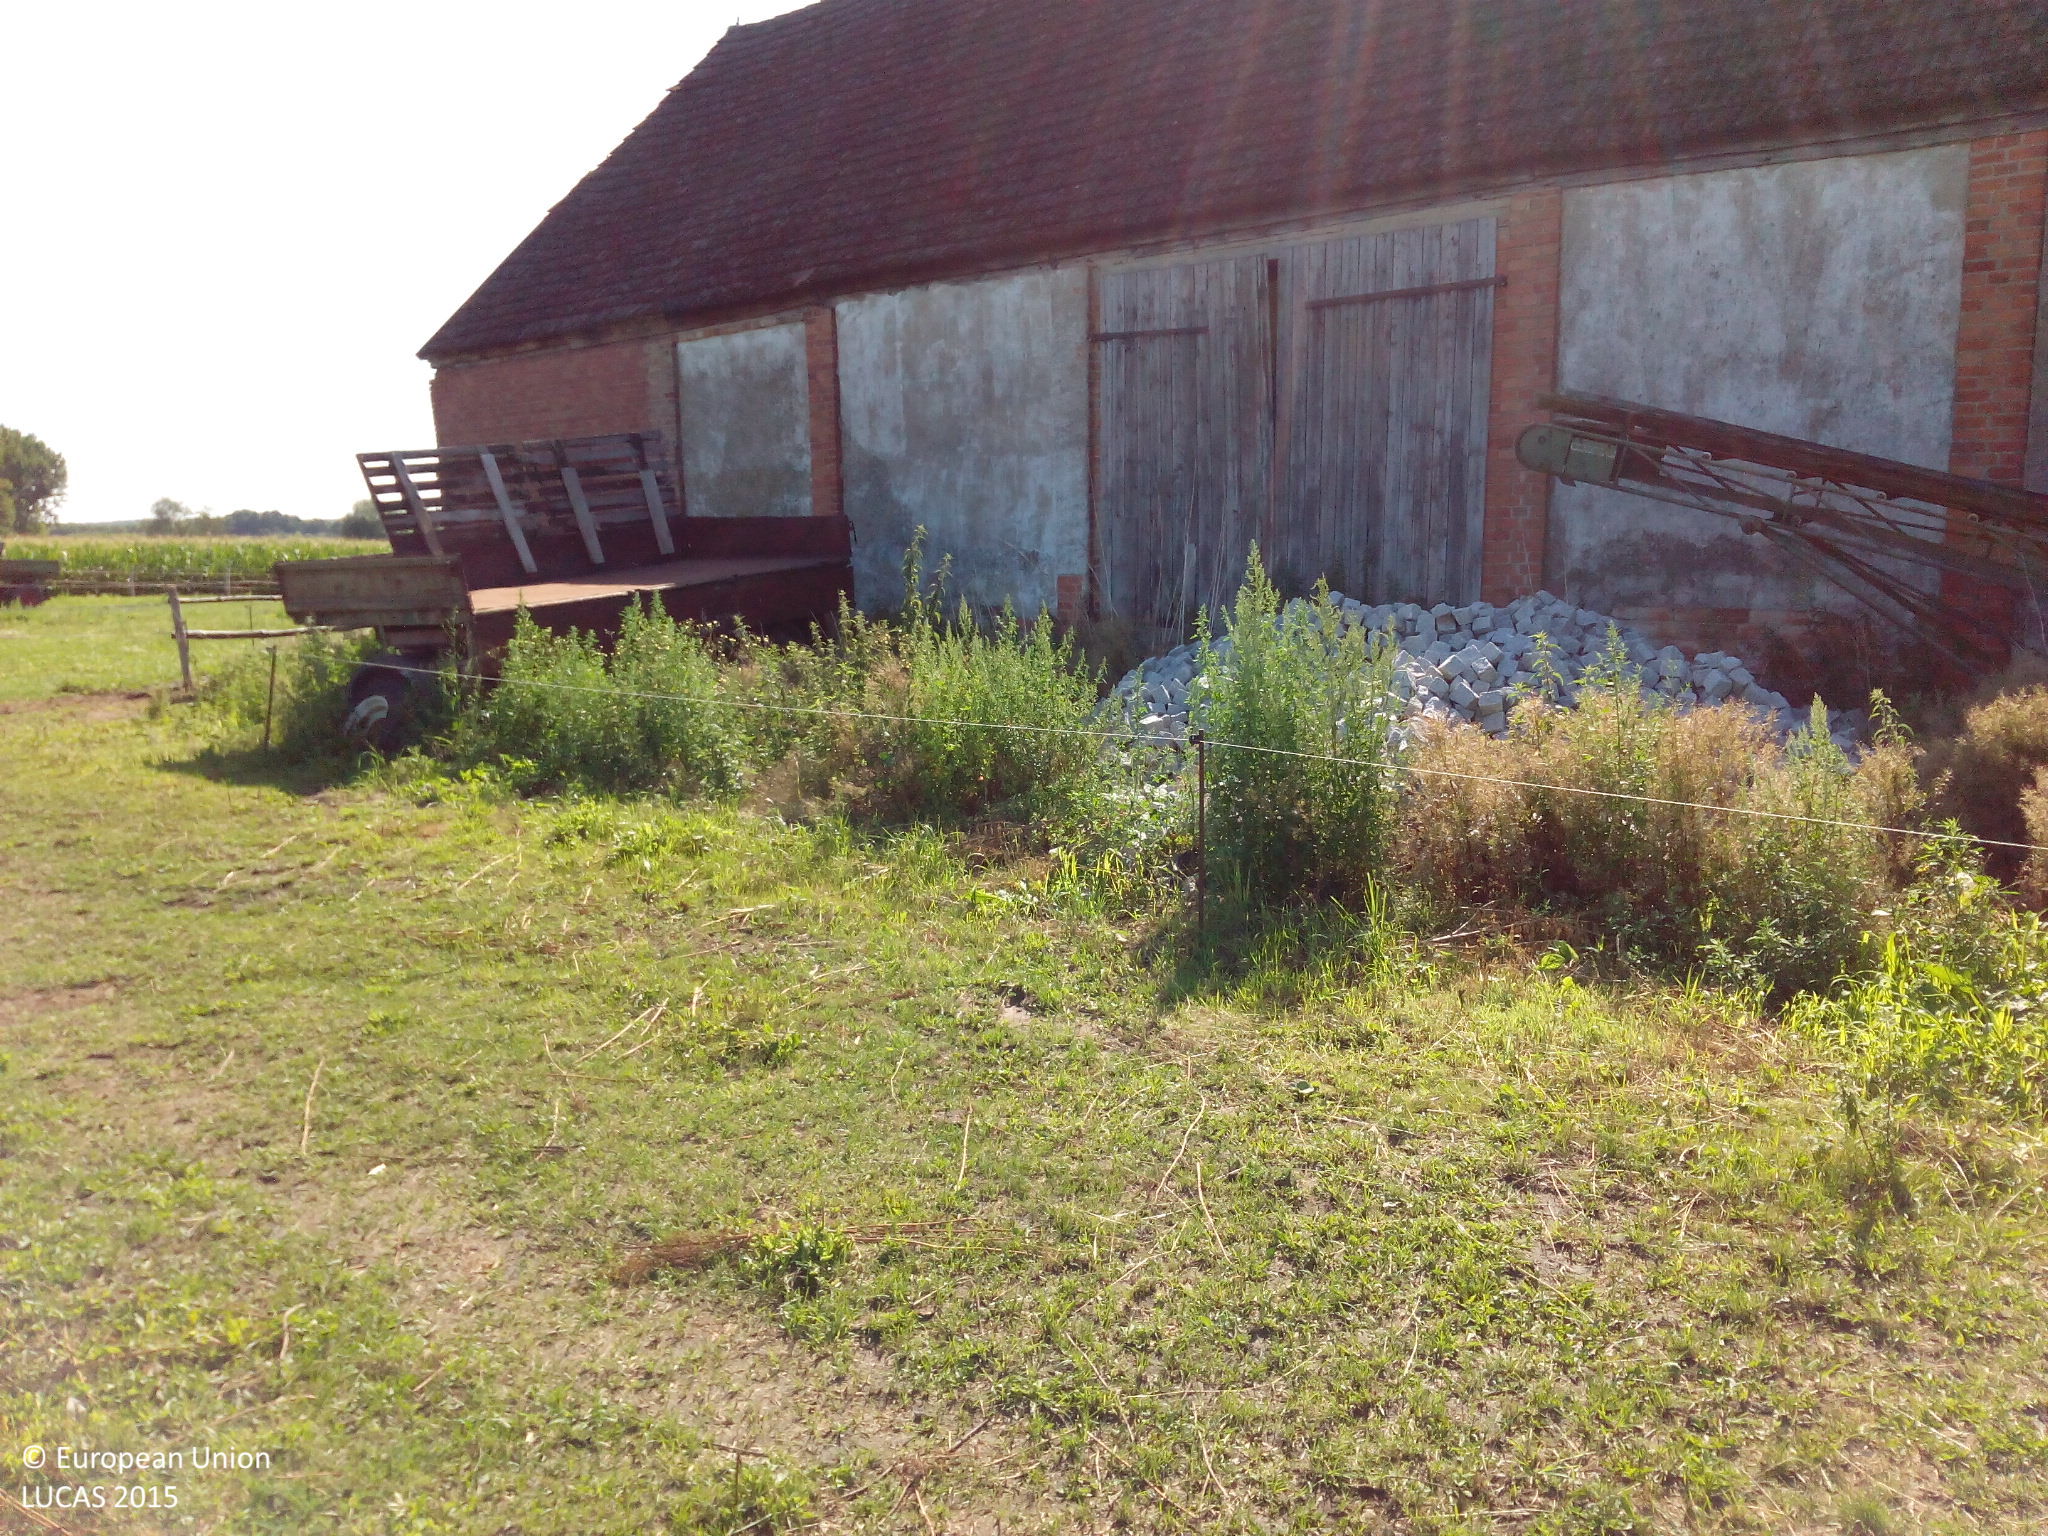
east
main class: Cropland
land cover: Maize
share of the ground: > 75 %
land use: Agriculture (excluding fallow land and kitchen gardens)
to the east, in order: Maize; Fences; Grassland without tree/shrub cover; Fences; Maize; Fences; Grassland without tree/shrub cover; Fences; Grassland without tree/shrub cover; Fences; Paved roads, cycling and walking lanes; Grass margins; Maize
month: July
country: DE
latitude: 52.7882
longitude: 14.2270
